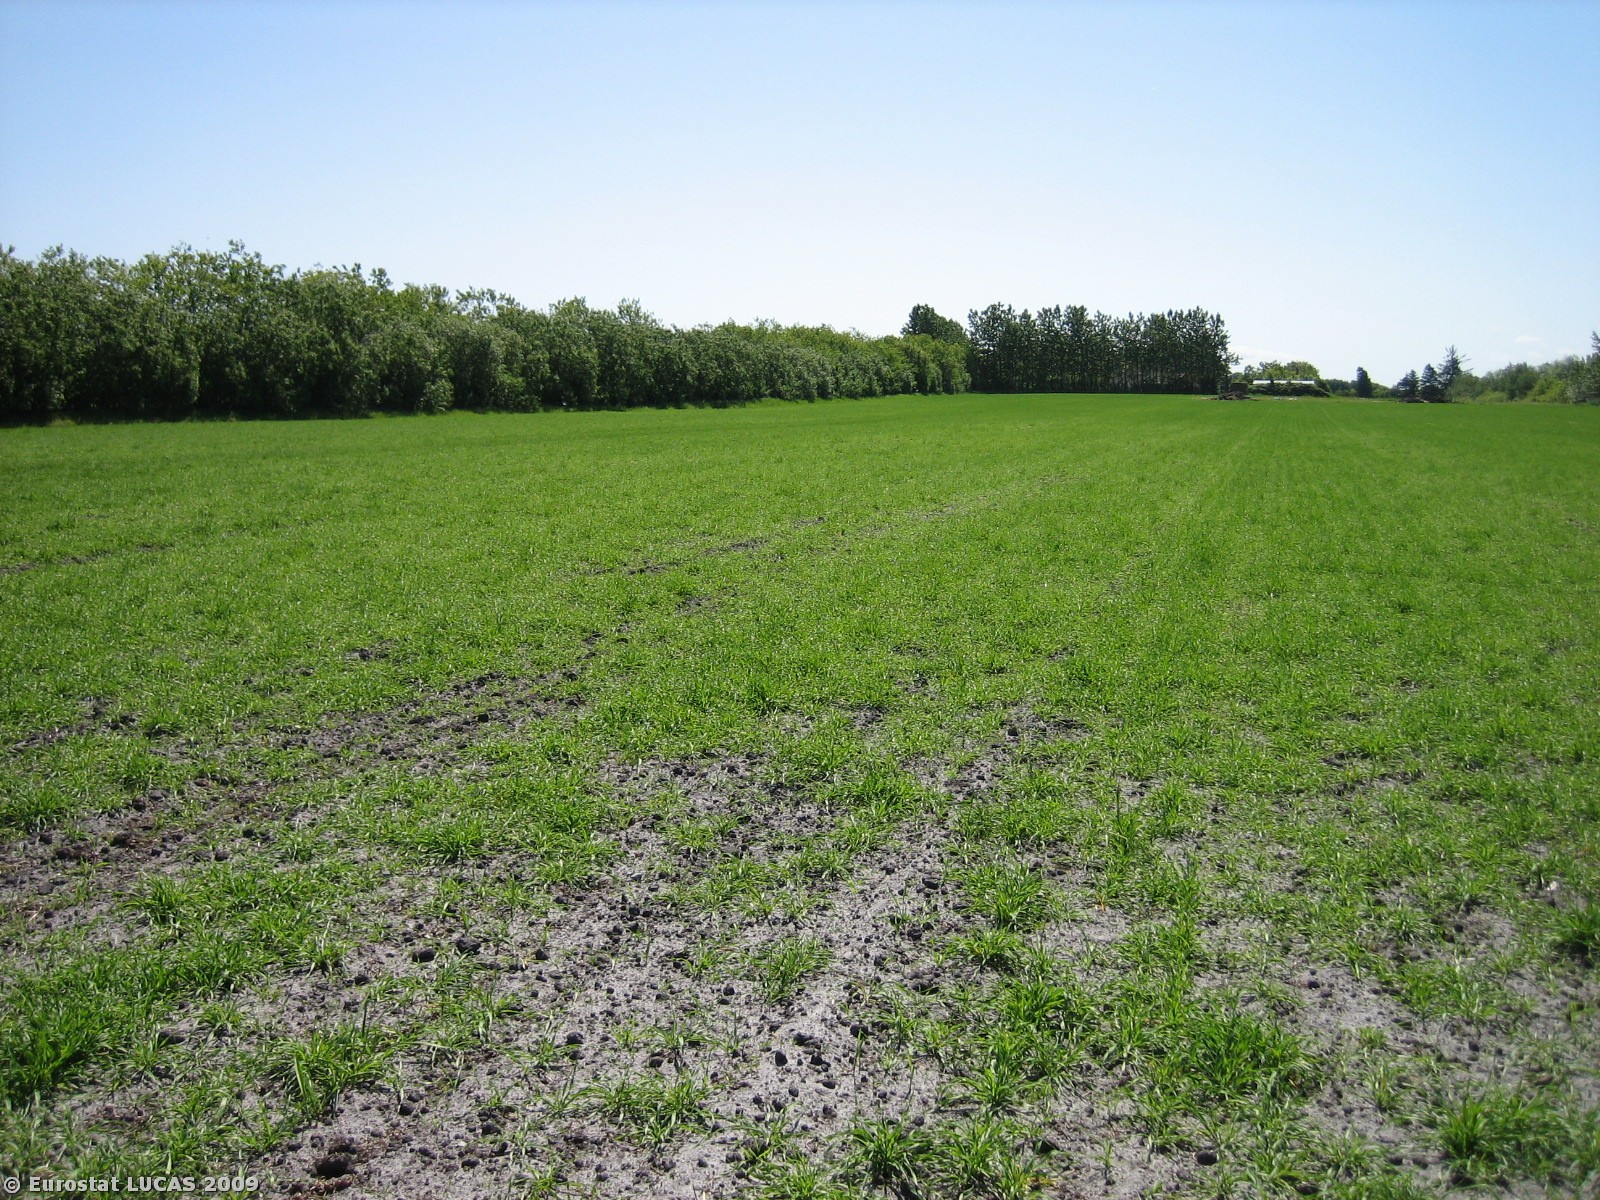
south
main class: Cropland
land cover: Barley
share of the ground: 50 - 75 %
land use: Agriculture (excluding fallow land and kitchen gardens)
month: May
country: DK
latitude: 55.8951
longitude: 8.8658
